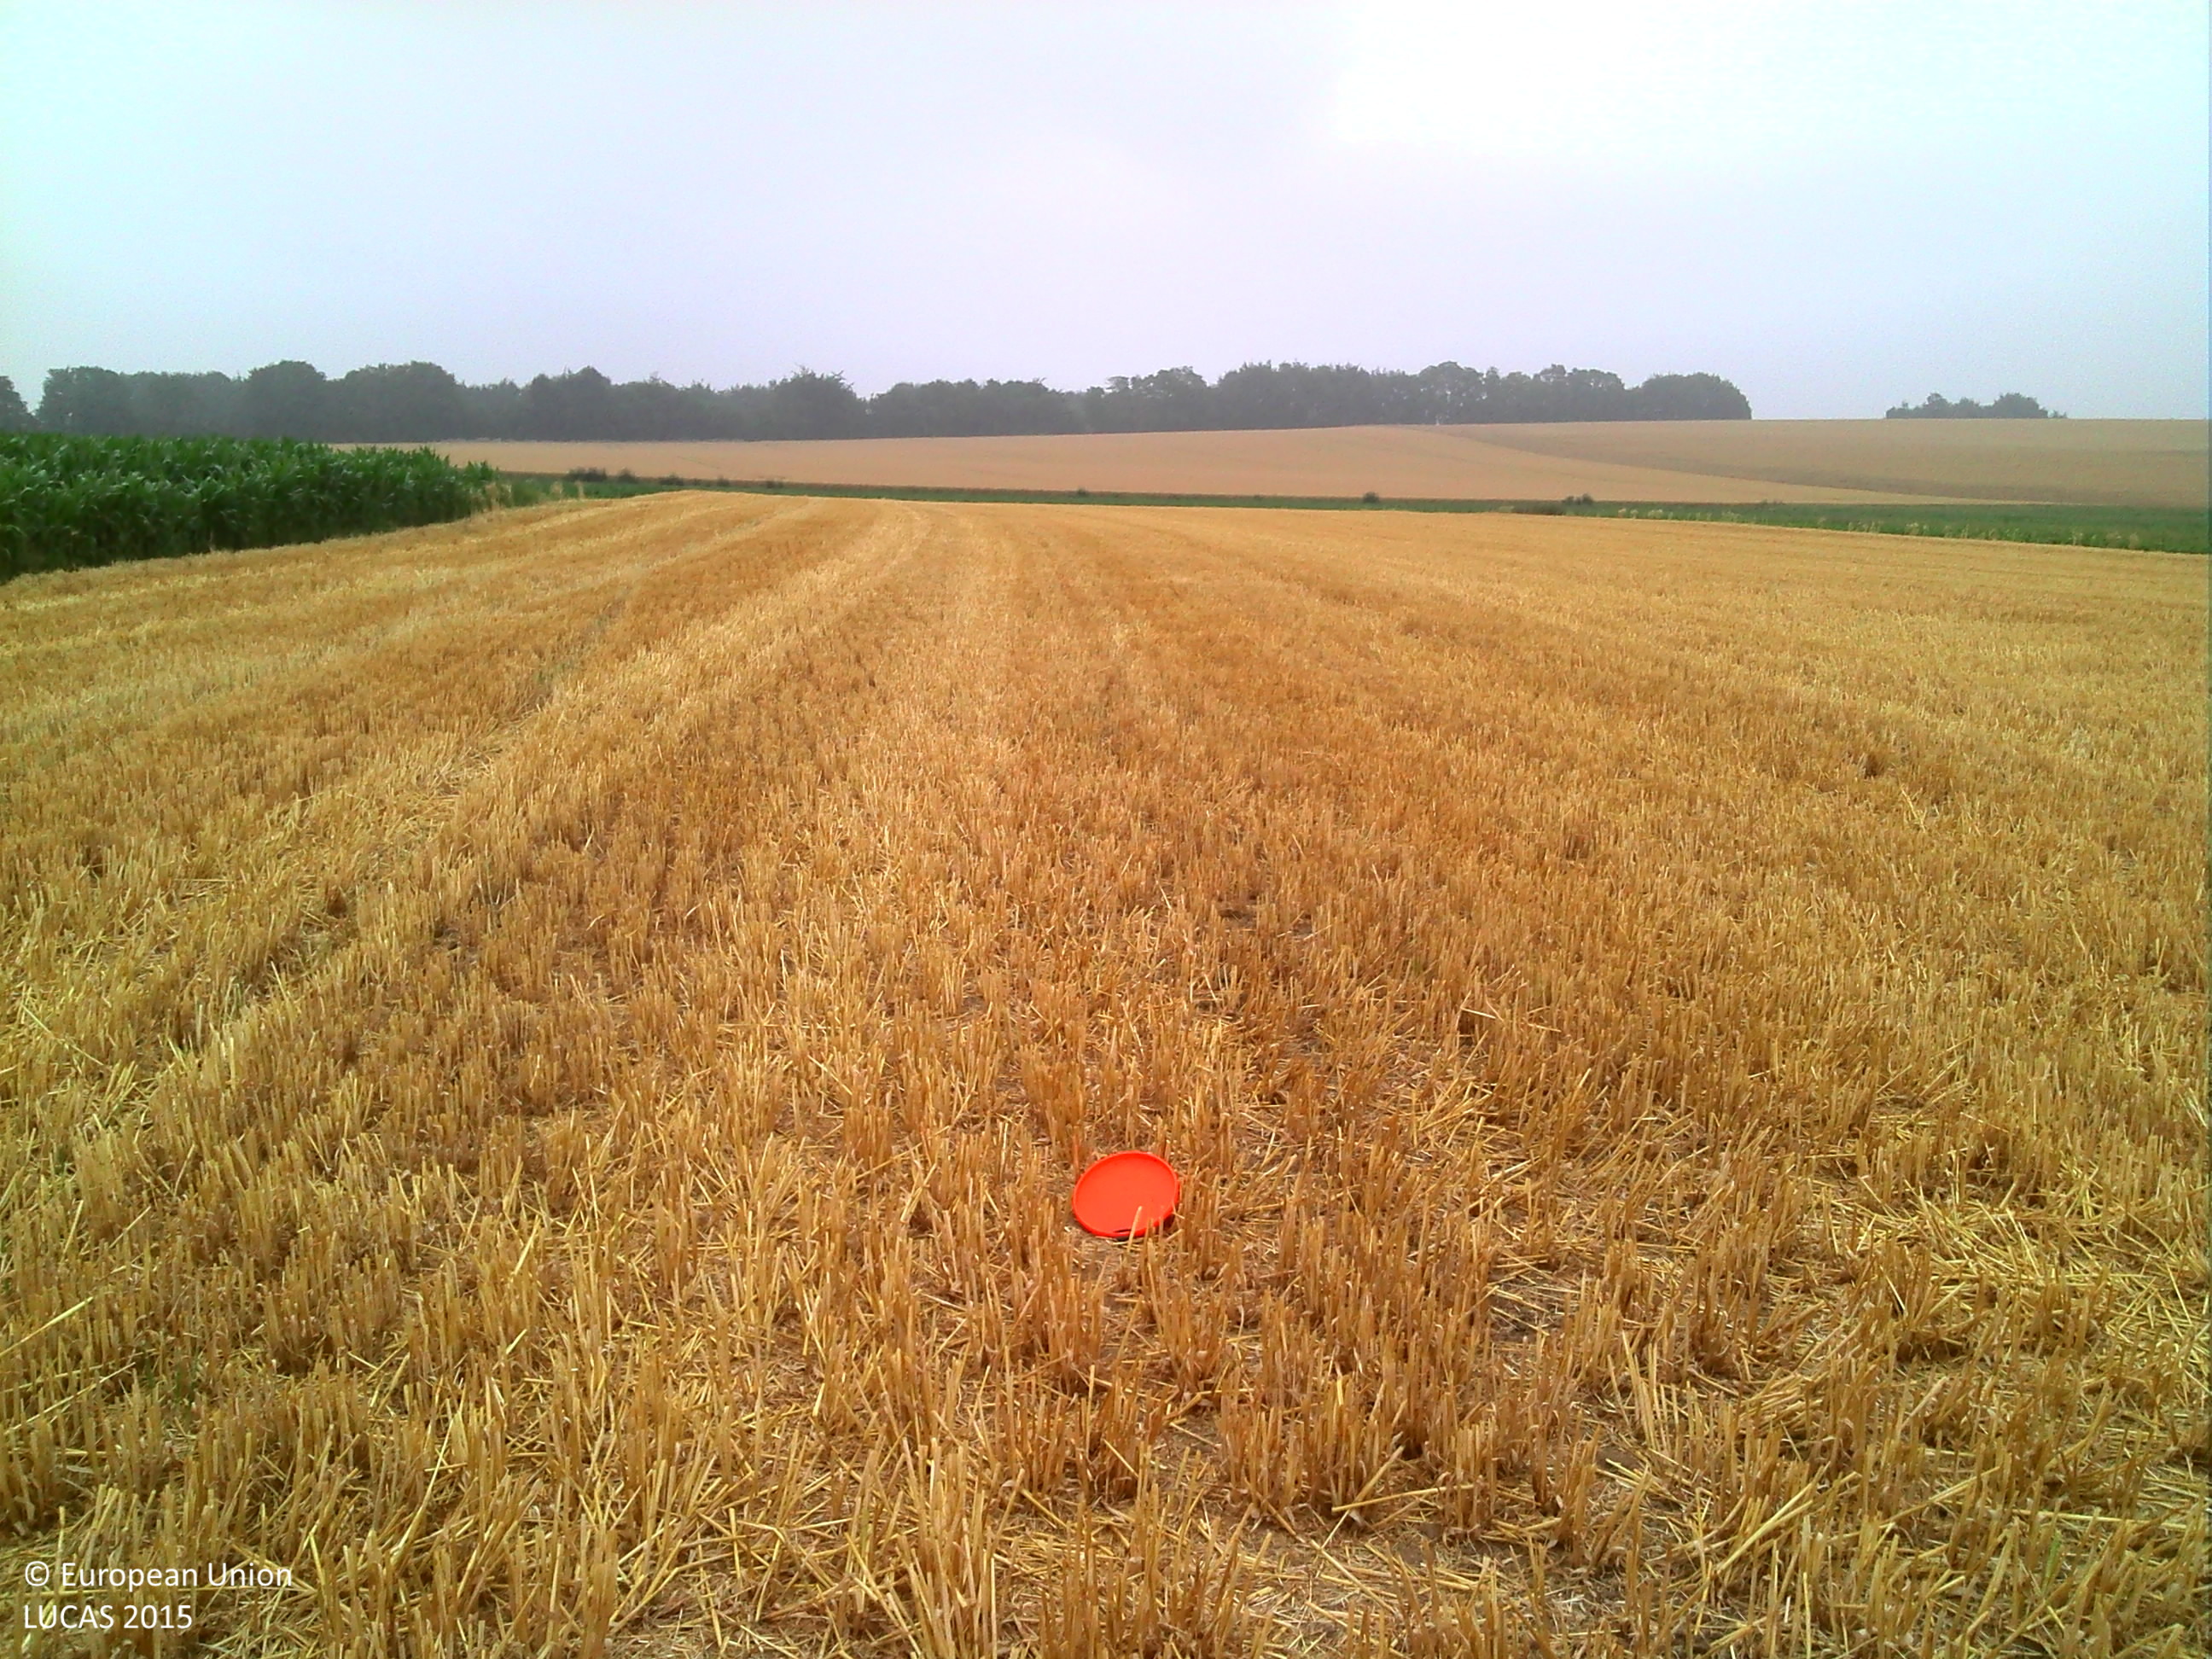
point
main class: Cropland
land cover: Barley
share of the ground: > 75 %
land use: Agriculture (excluding fallow land and kitchen gardens)
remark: Harvested field
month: July
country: BE
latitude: 50.7641
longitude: 5.5606
